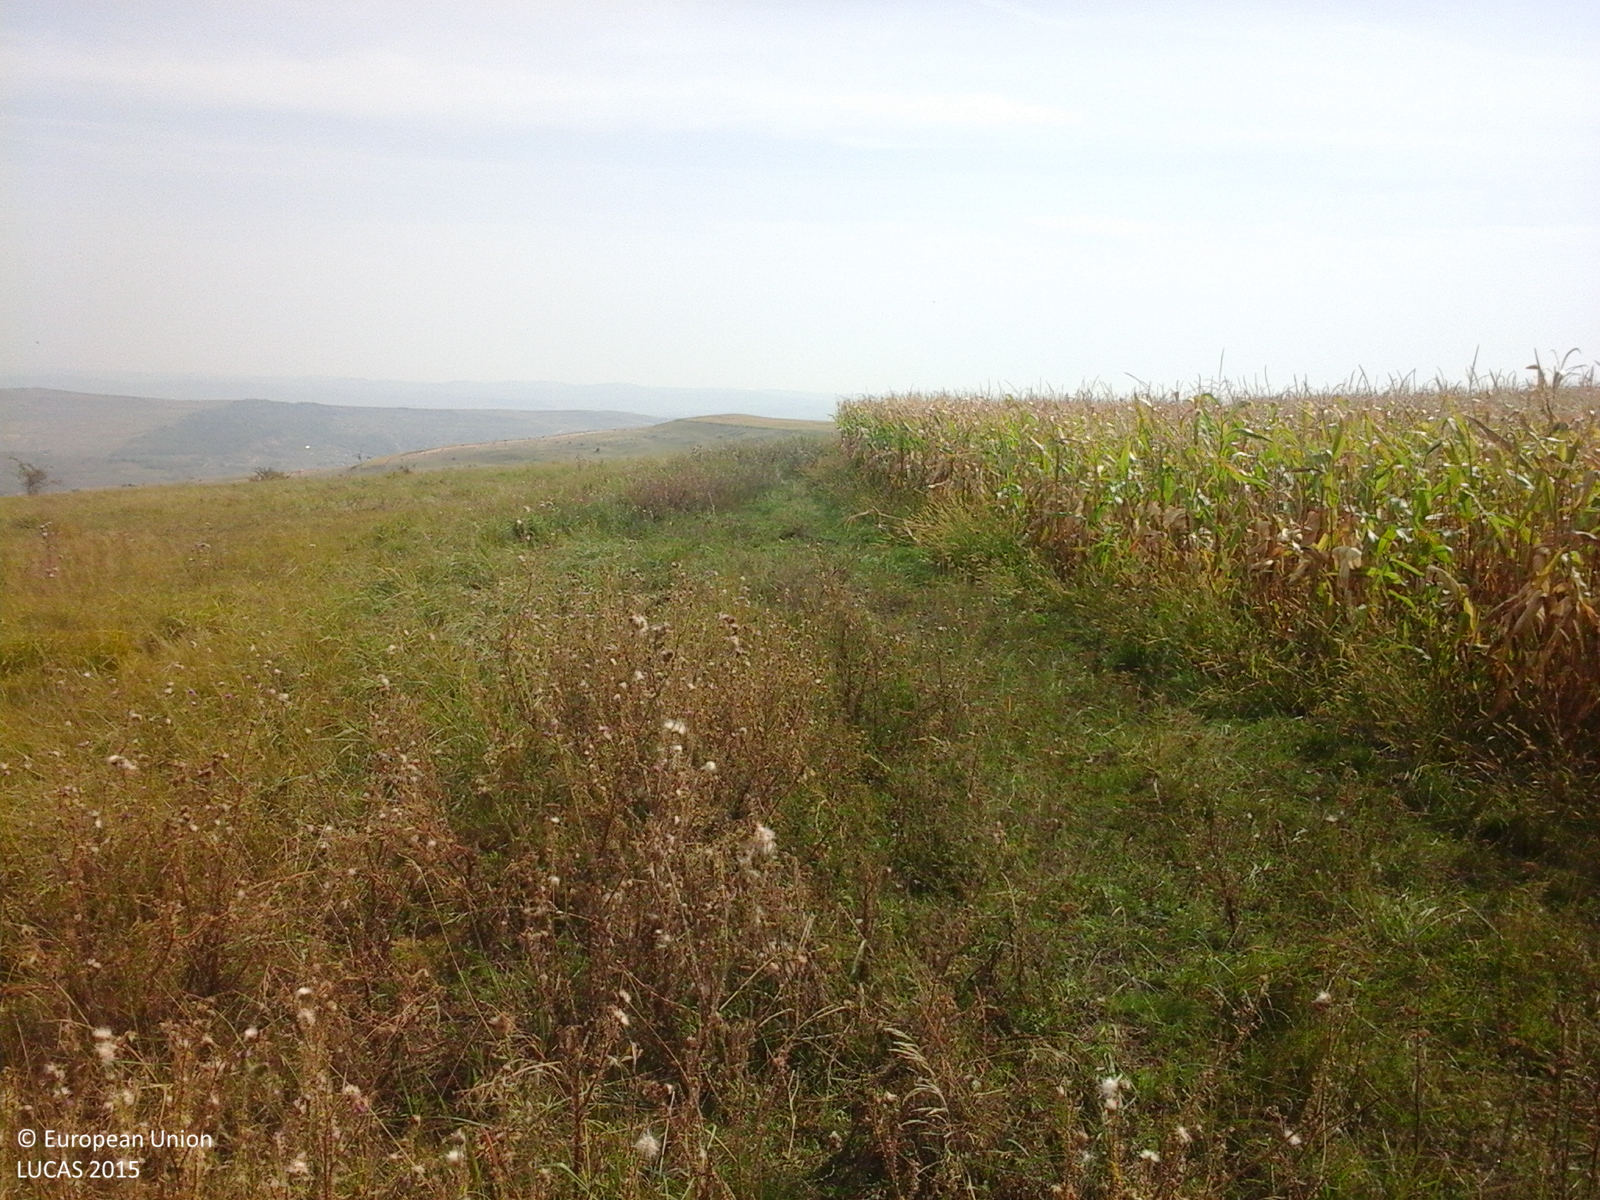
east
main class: Grassland
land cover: Grassland without tree/shrub cover
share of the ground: > 75 %
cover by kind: herbaceous plants 100 %
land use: Agriculture (excluding fallow land and kitchen gardens)
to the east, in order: Grassland without tree/shrub cover; Tracks; Grassland without tree/shrub cover; Grassland with sparse tree/shrub cover
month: September
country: RO
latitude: 46.8411
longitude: 23.6438
